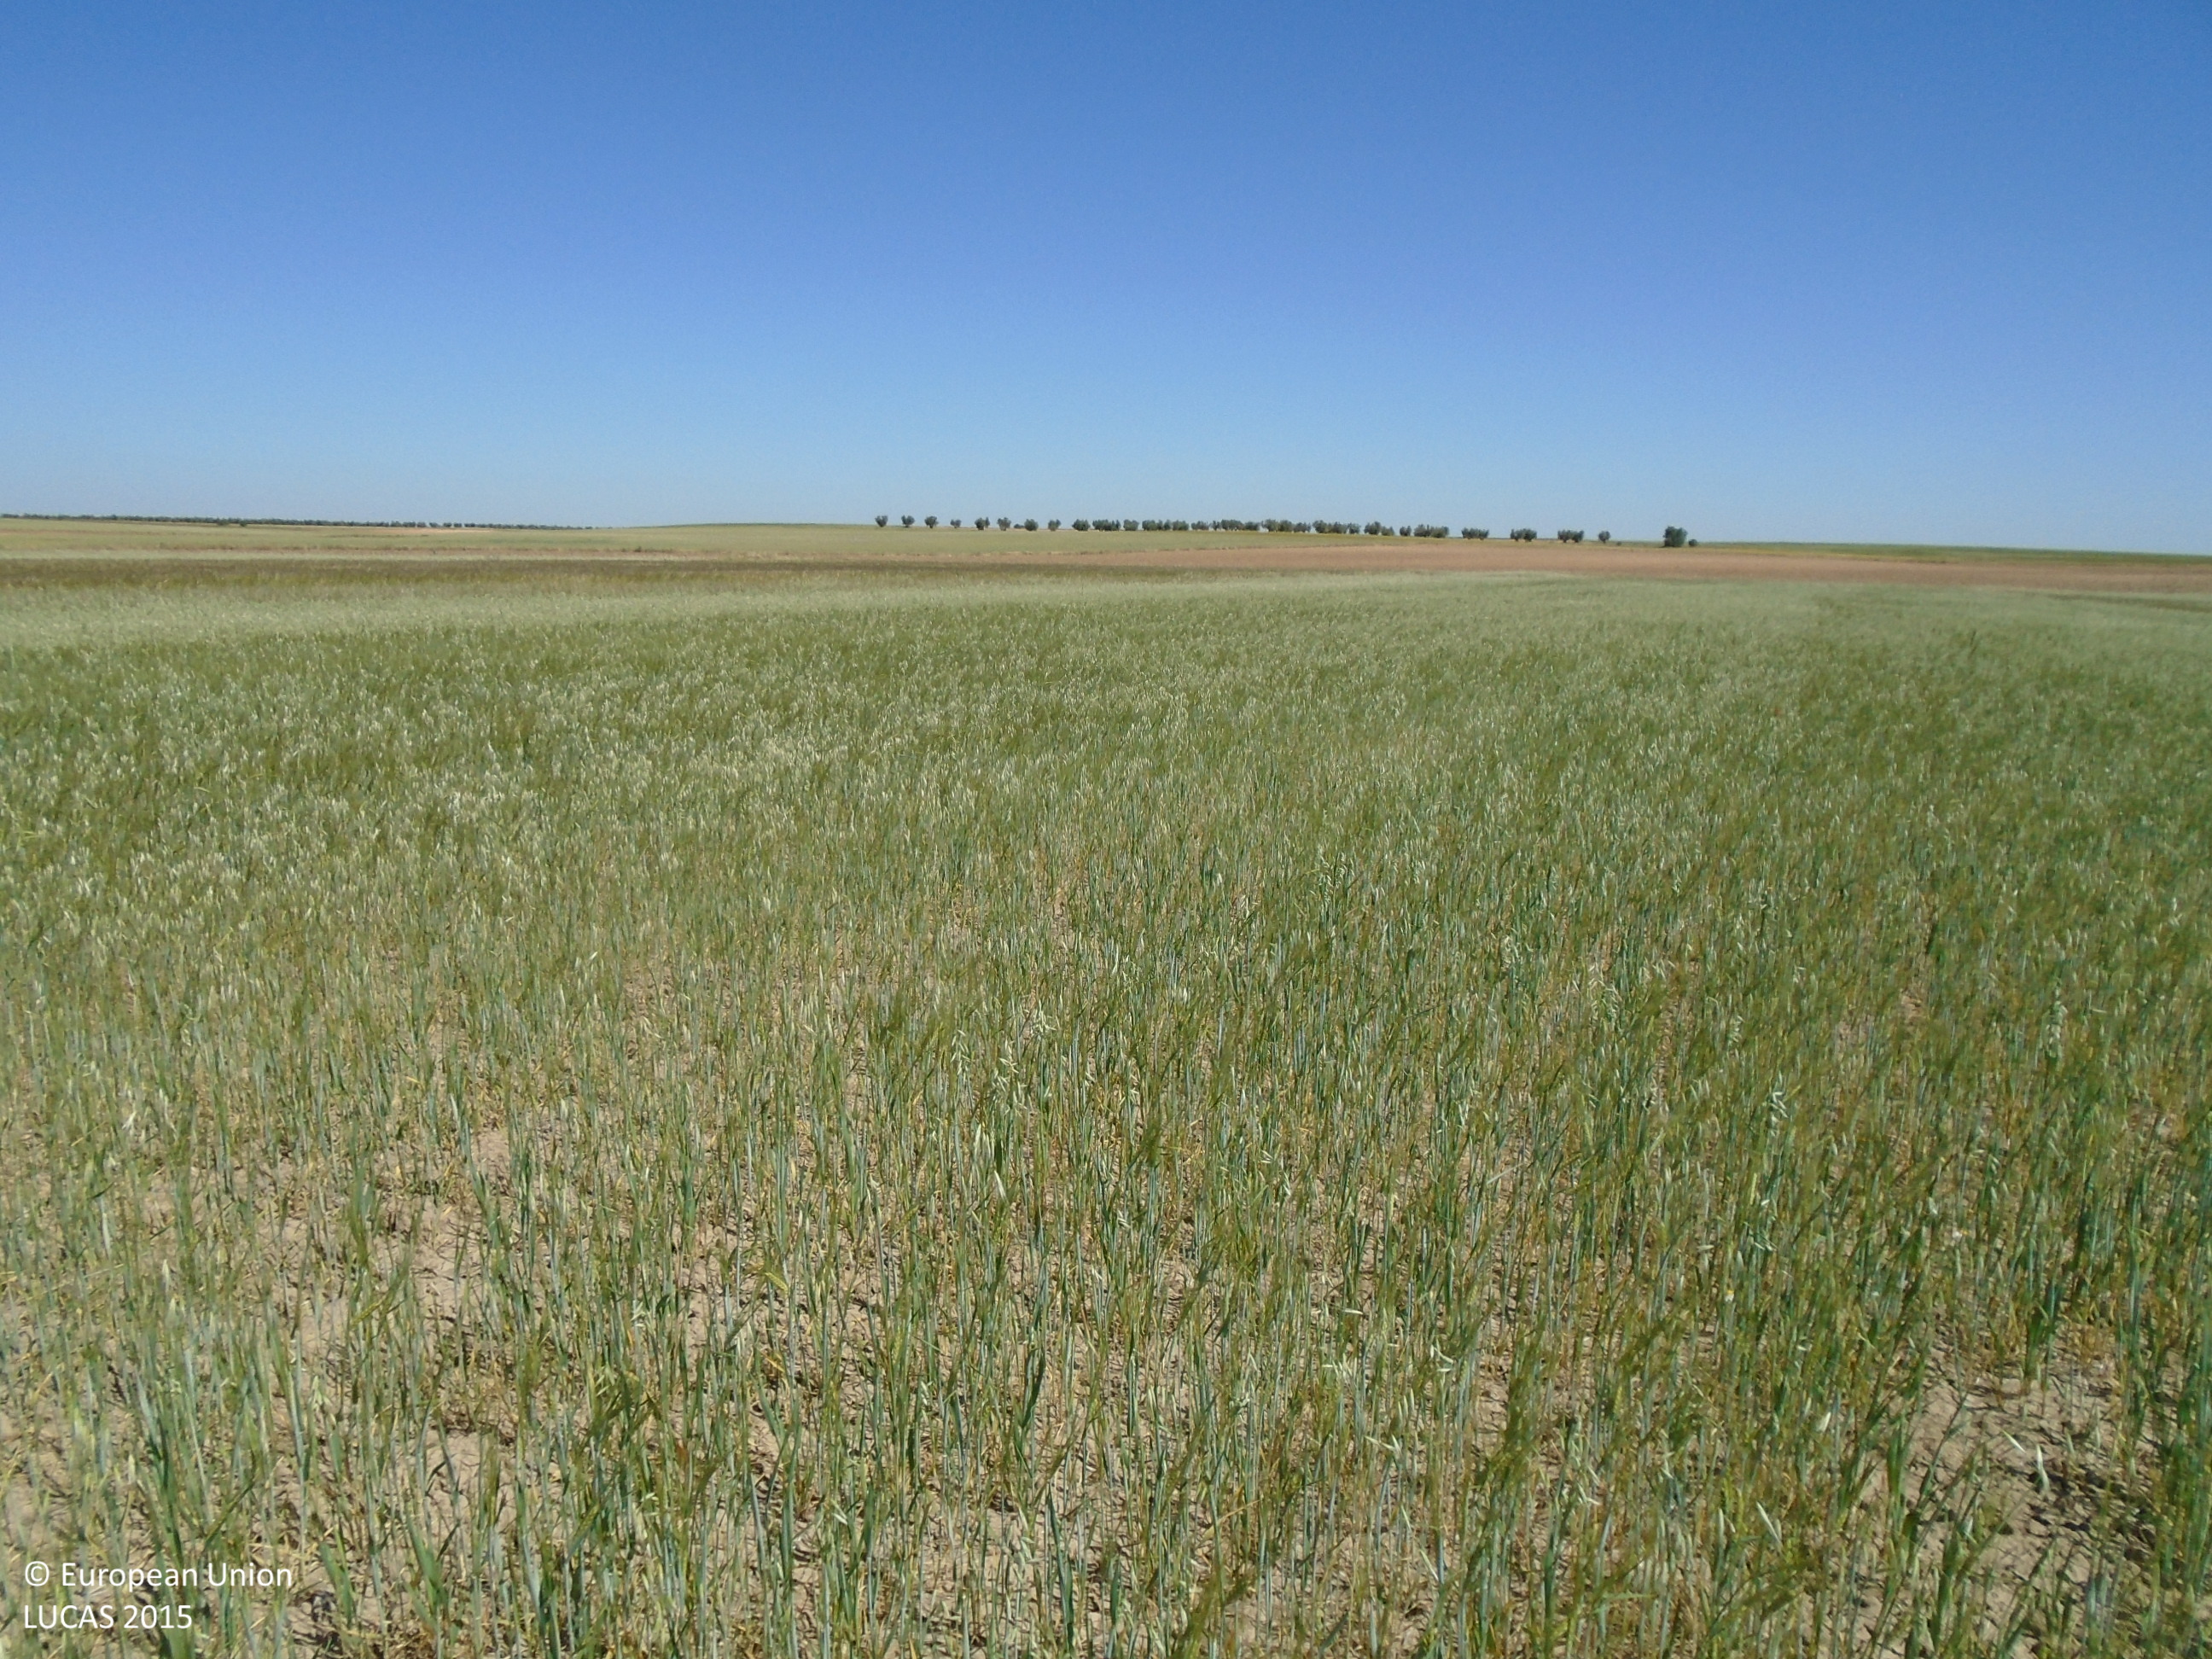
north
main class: Cropland
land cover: Common wheat
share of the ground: > 75 %
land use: Agriculture (excluding fallow land and kitchen gardens)
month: May
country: ES
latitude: 39.7484
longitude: -3.6475
